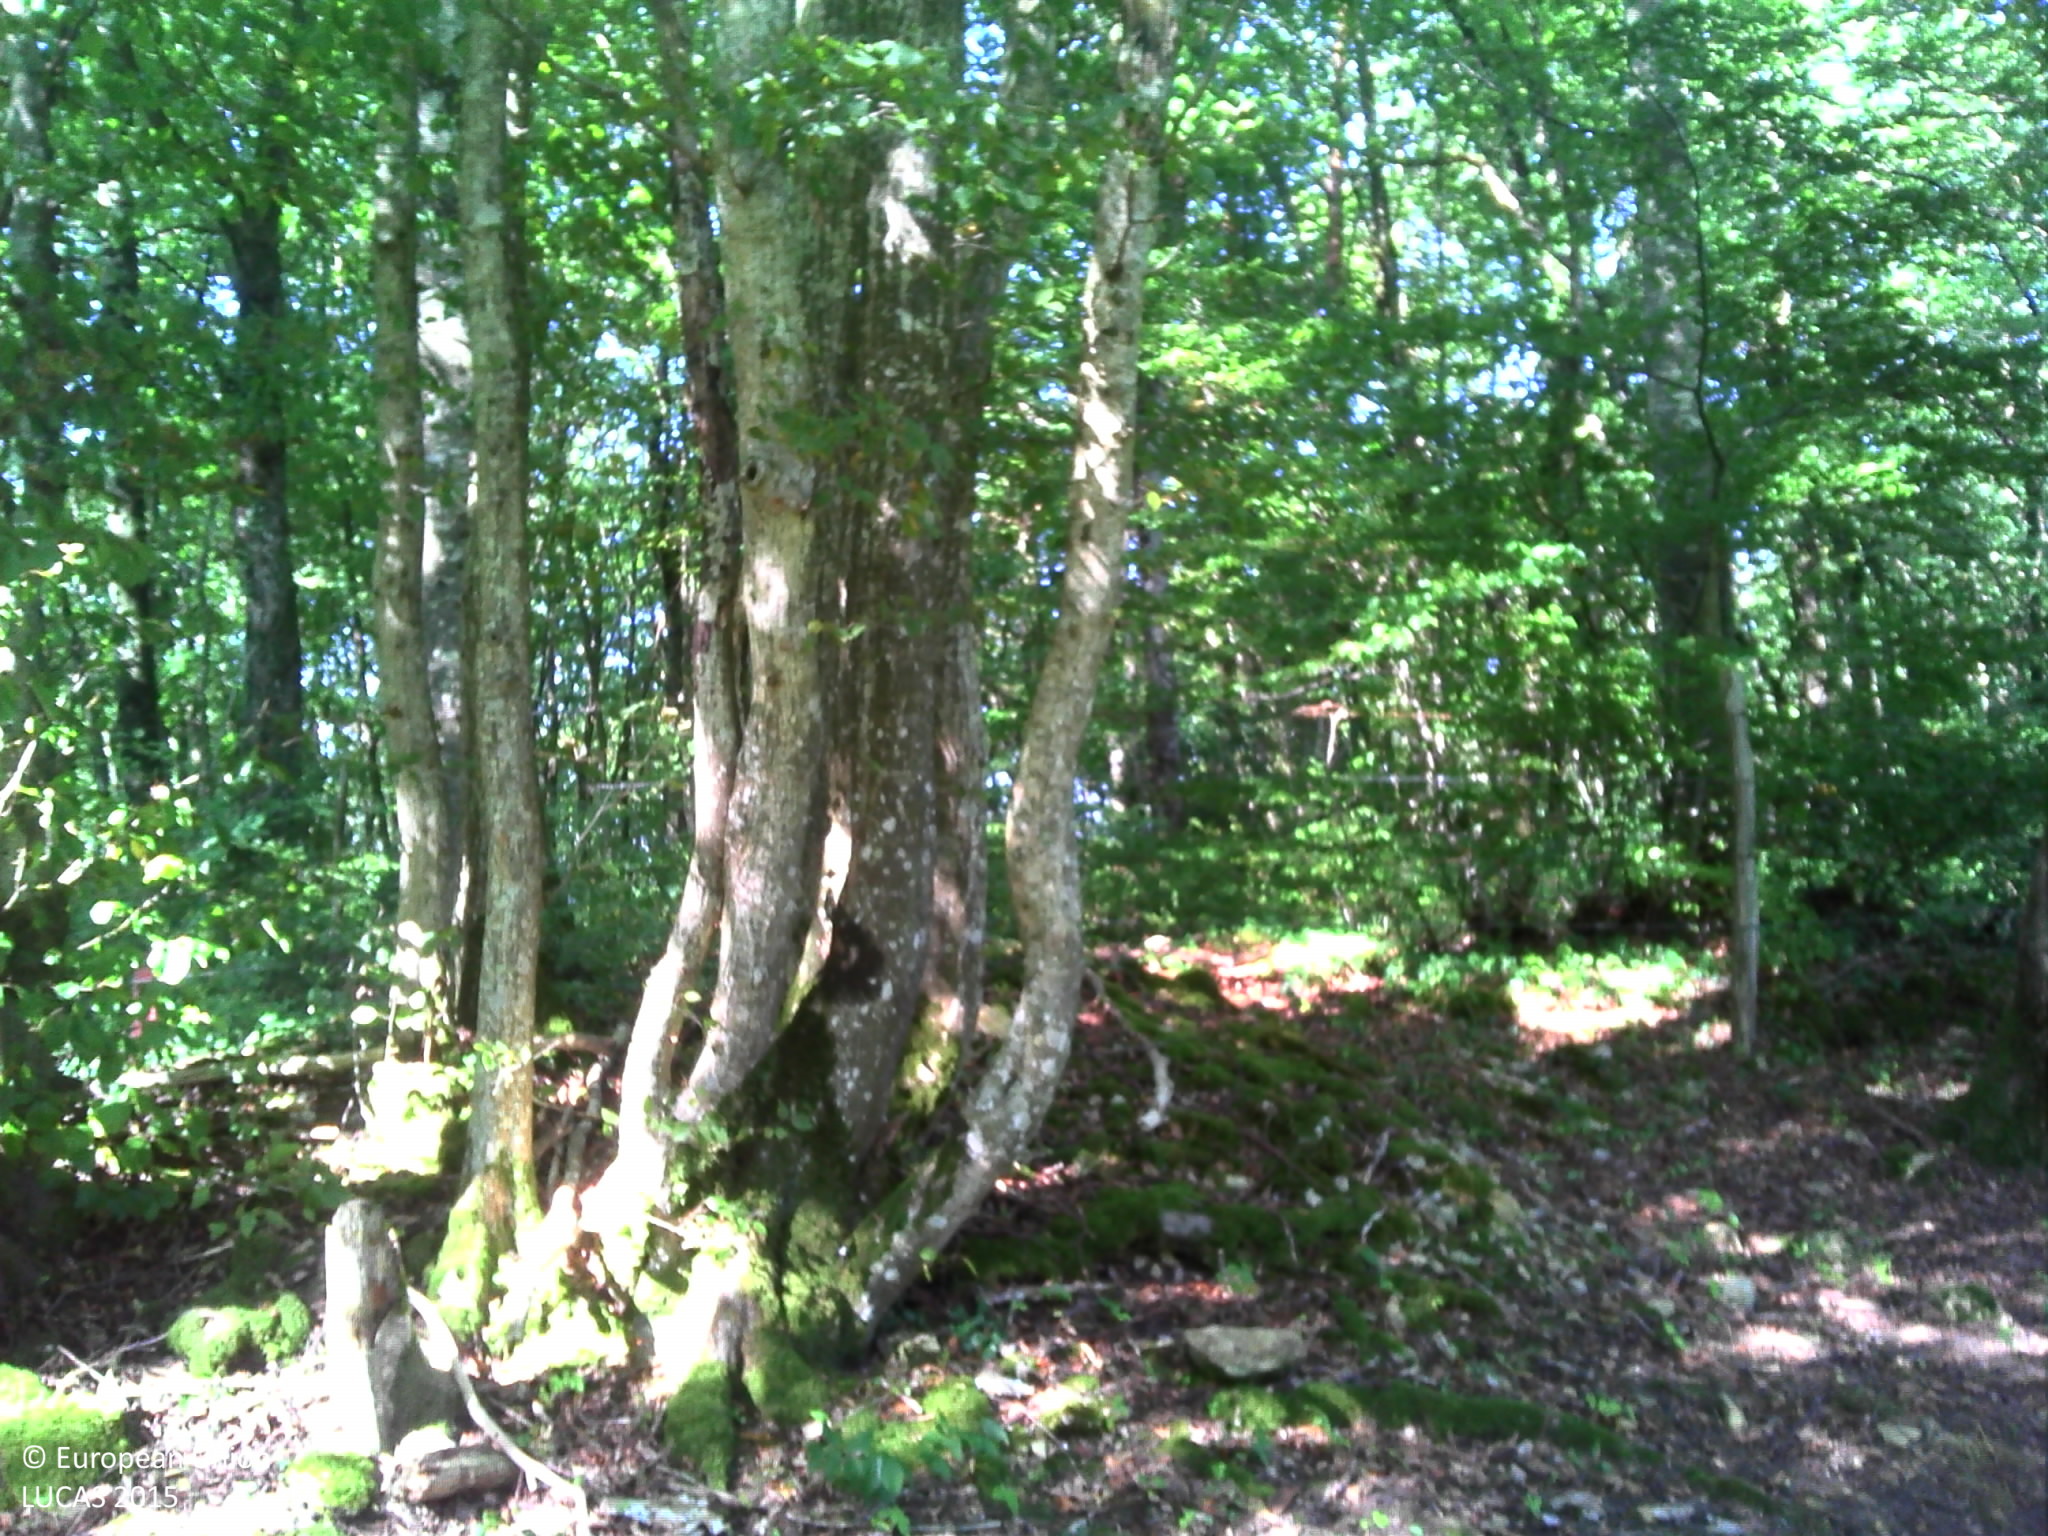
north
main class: Woodland
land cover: Broadleaved woodland
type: beech forest
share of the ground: > 75 %
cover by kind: broadleaved forest trees 90 %, unconsolidated bare surface 10 %
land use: Forestry
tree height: > 5 m
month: September
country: FR
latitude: 47.2431
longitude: 6.3160
